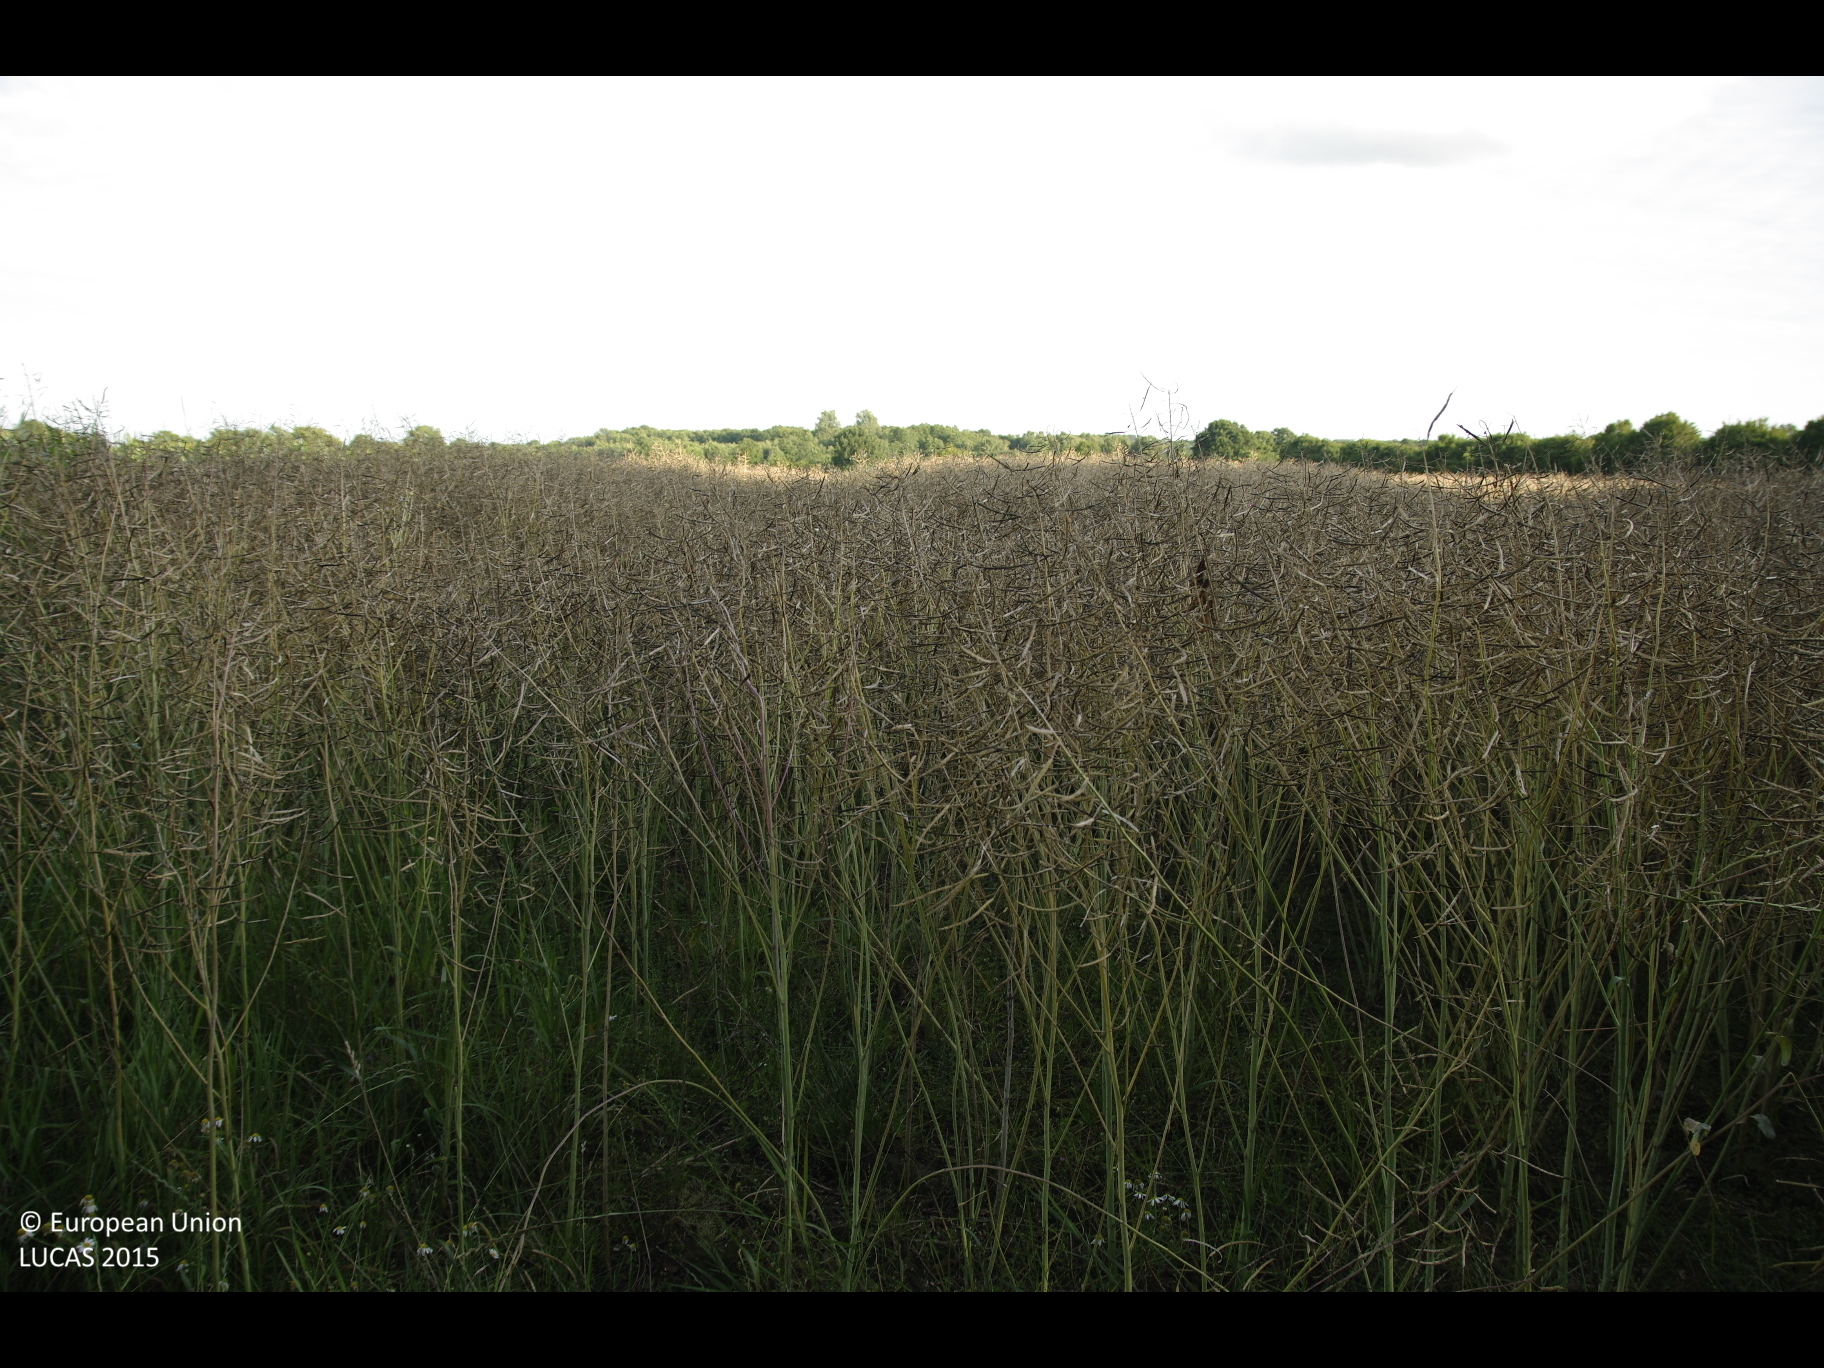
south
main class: Cropland
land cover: Rape and turnip rape
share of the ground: > 75 %
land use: Agriculture (excluding fallow land and kitchen gardens)
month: July
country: DE
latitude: 53.9769
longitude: 9.8324
